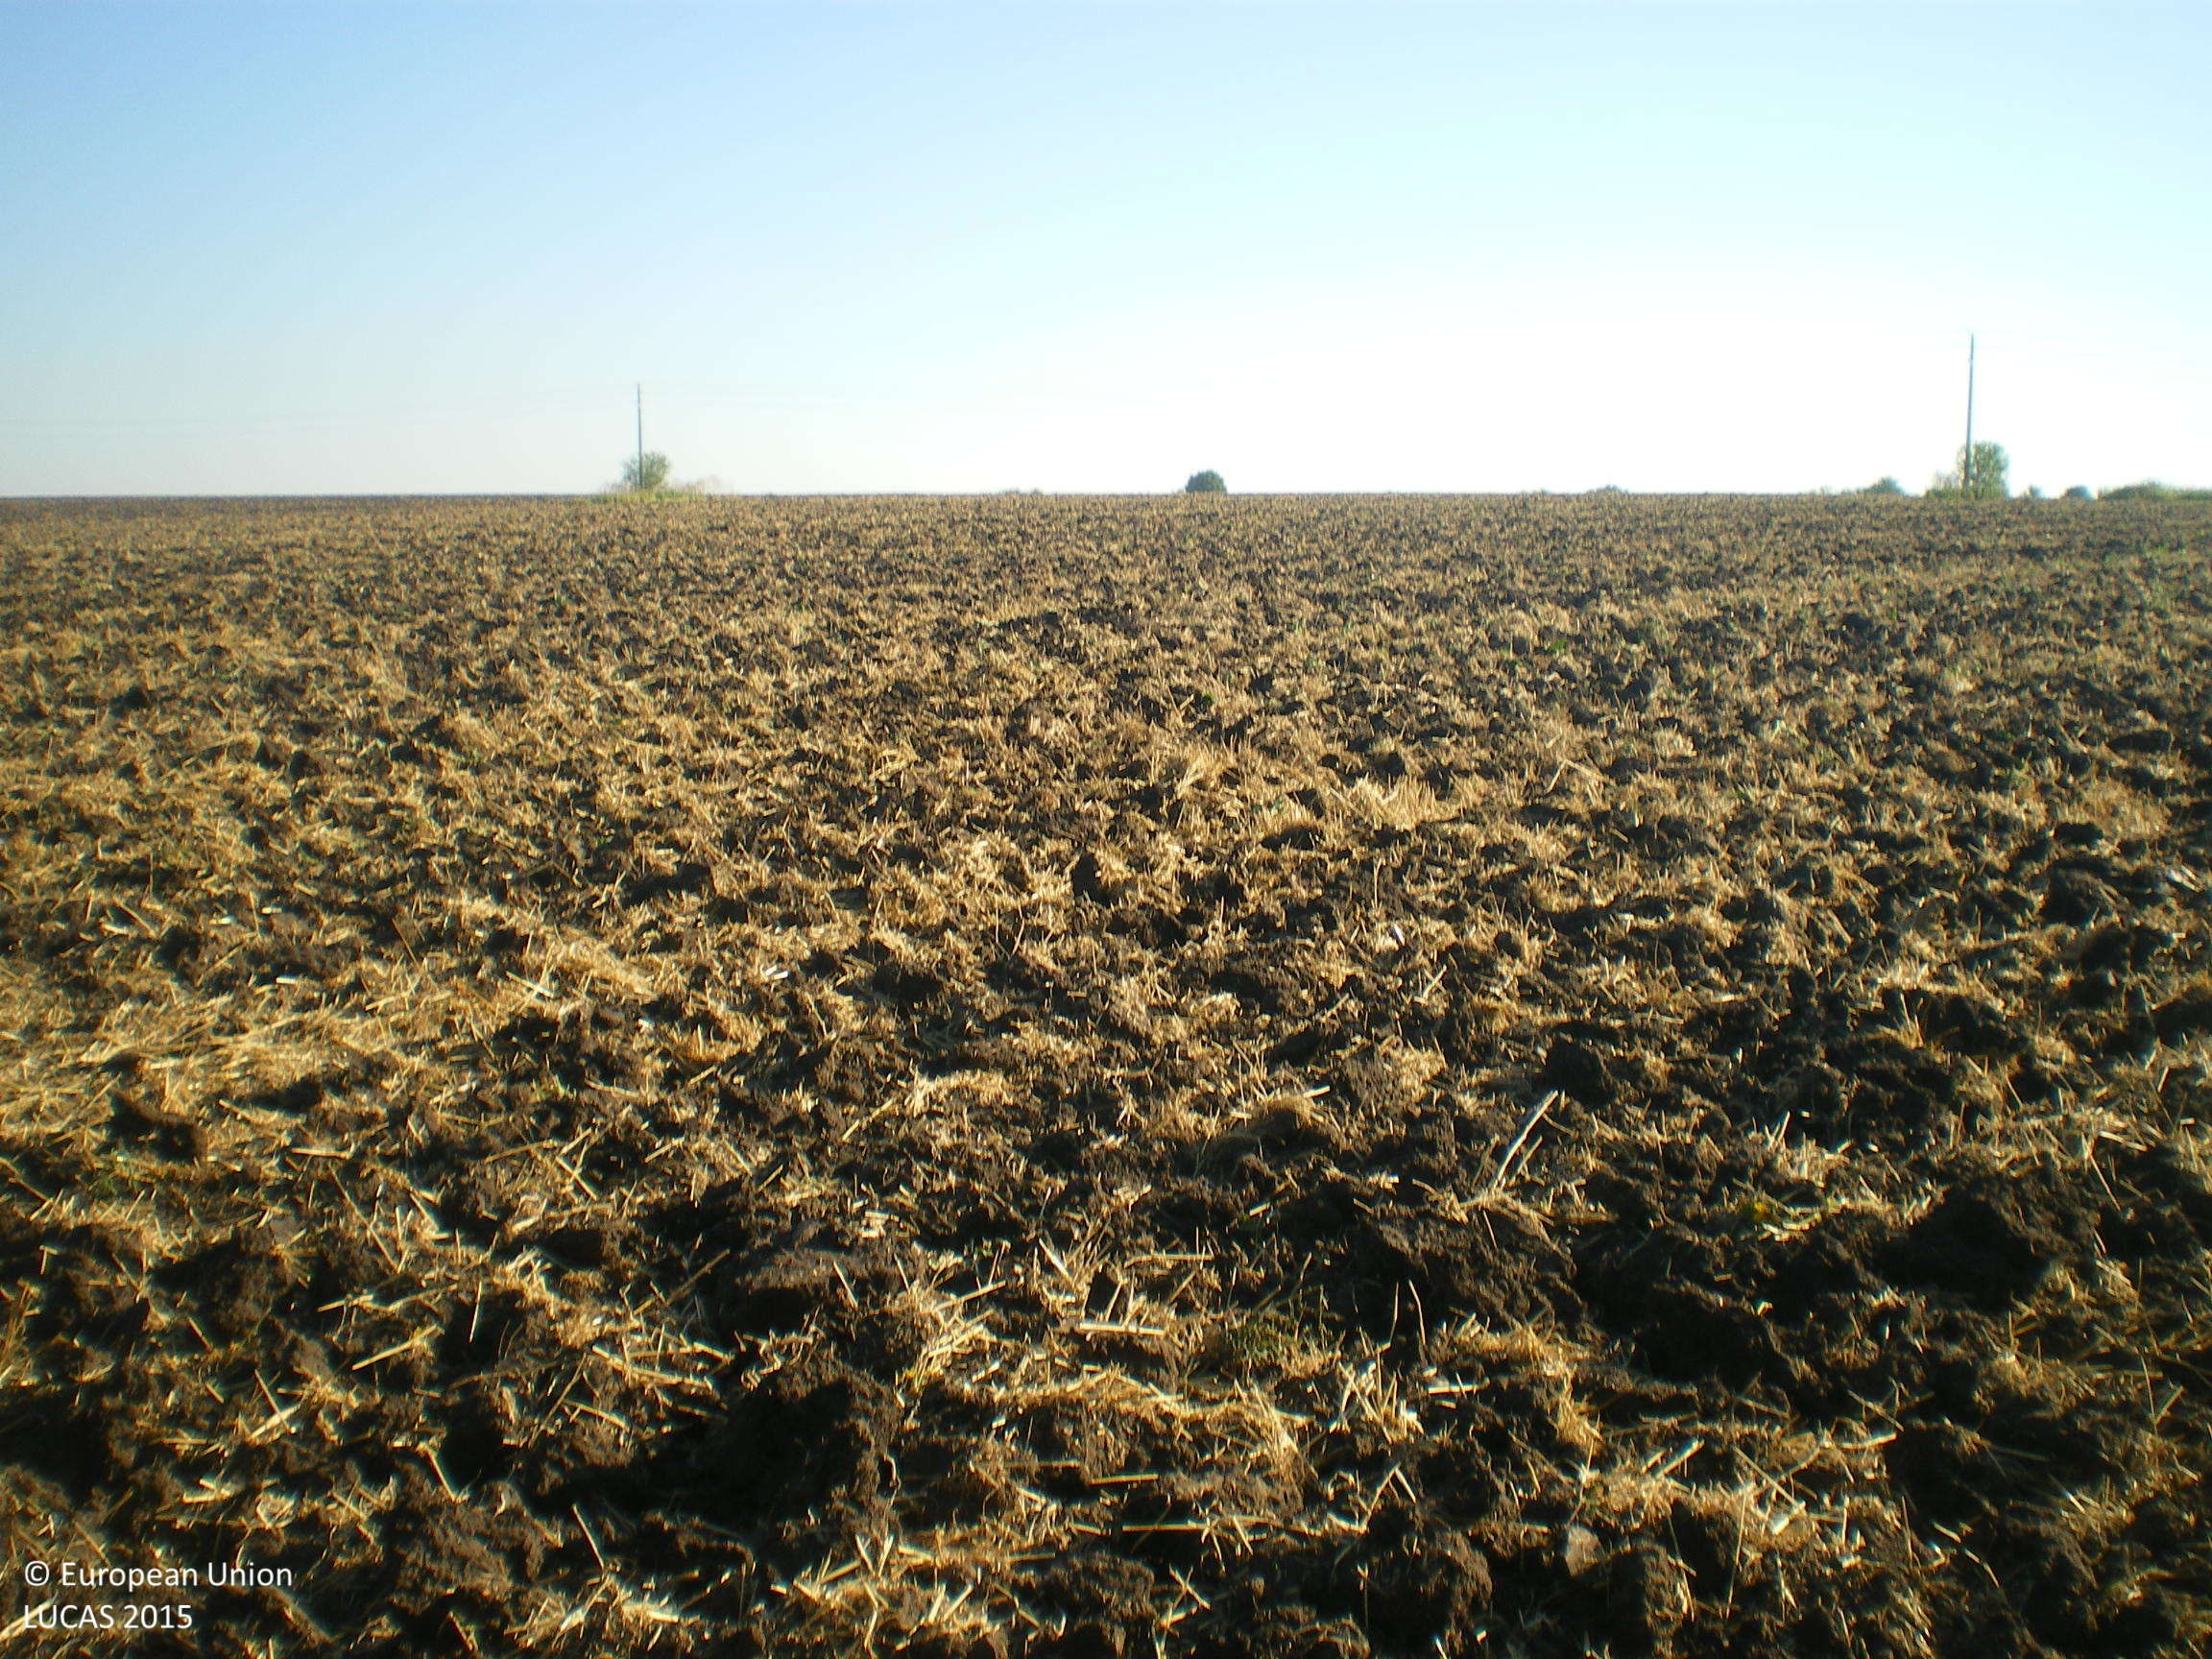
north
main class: Cropland
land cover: Common wheat
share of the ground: < 10 %
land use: Agriculture (excluding fallow land and kitchen gardens)
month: July
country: BG
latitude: 42.0718
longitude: 25.6472
